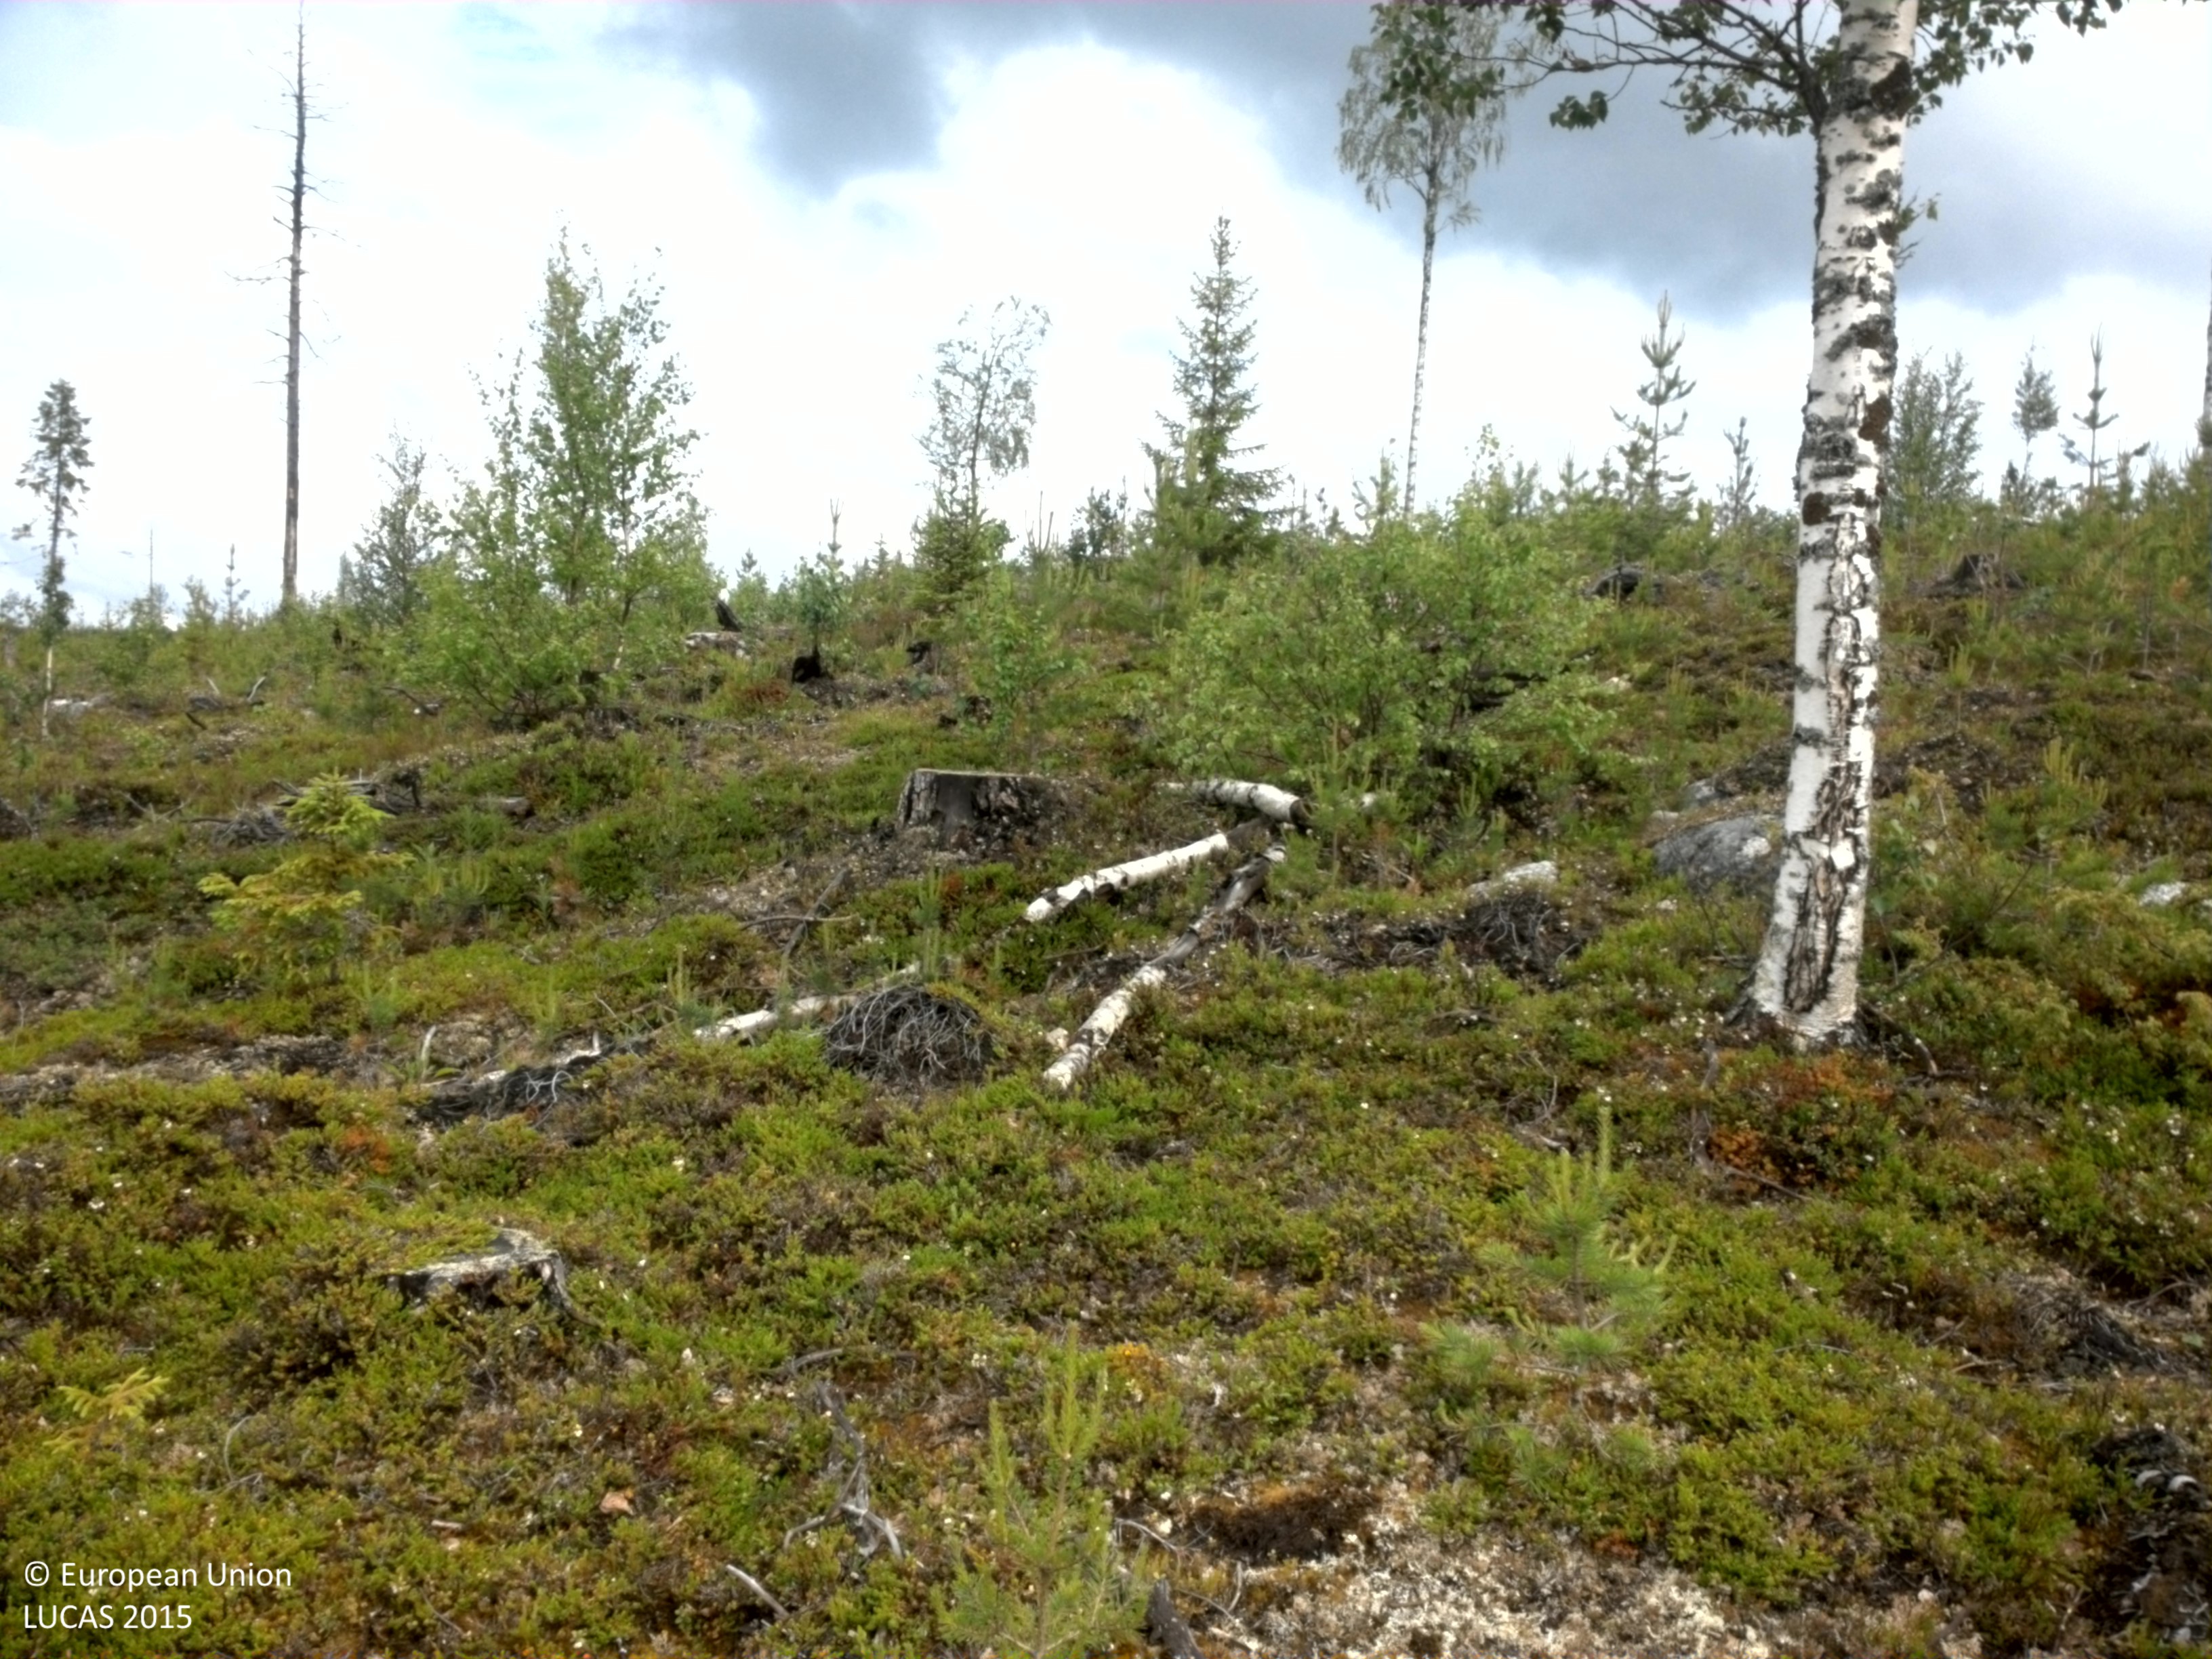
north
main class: Woodland
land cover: Pine dominated mixed woodland
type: boreal forest
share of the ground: 10 - 25 %
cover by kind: shrubs 50 %, lichens and mosses 30 %, coniferous forest trees 15 %, broadleaved forest trees 5 %
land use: Forestry
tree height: < 5 m
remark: Clear cut
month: July
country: SE
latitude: 64.6565
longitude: 18.2373
